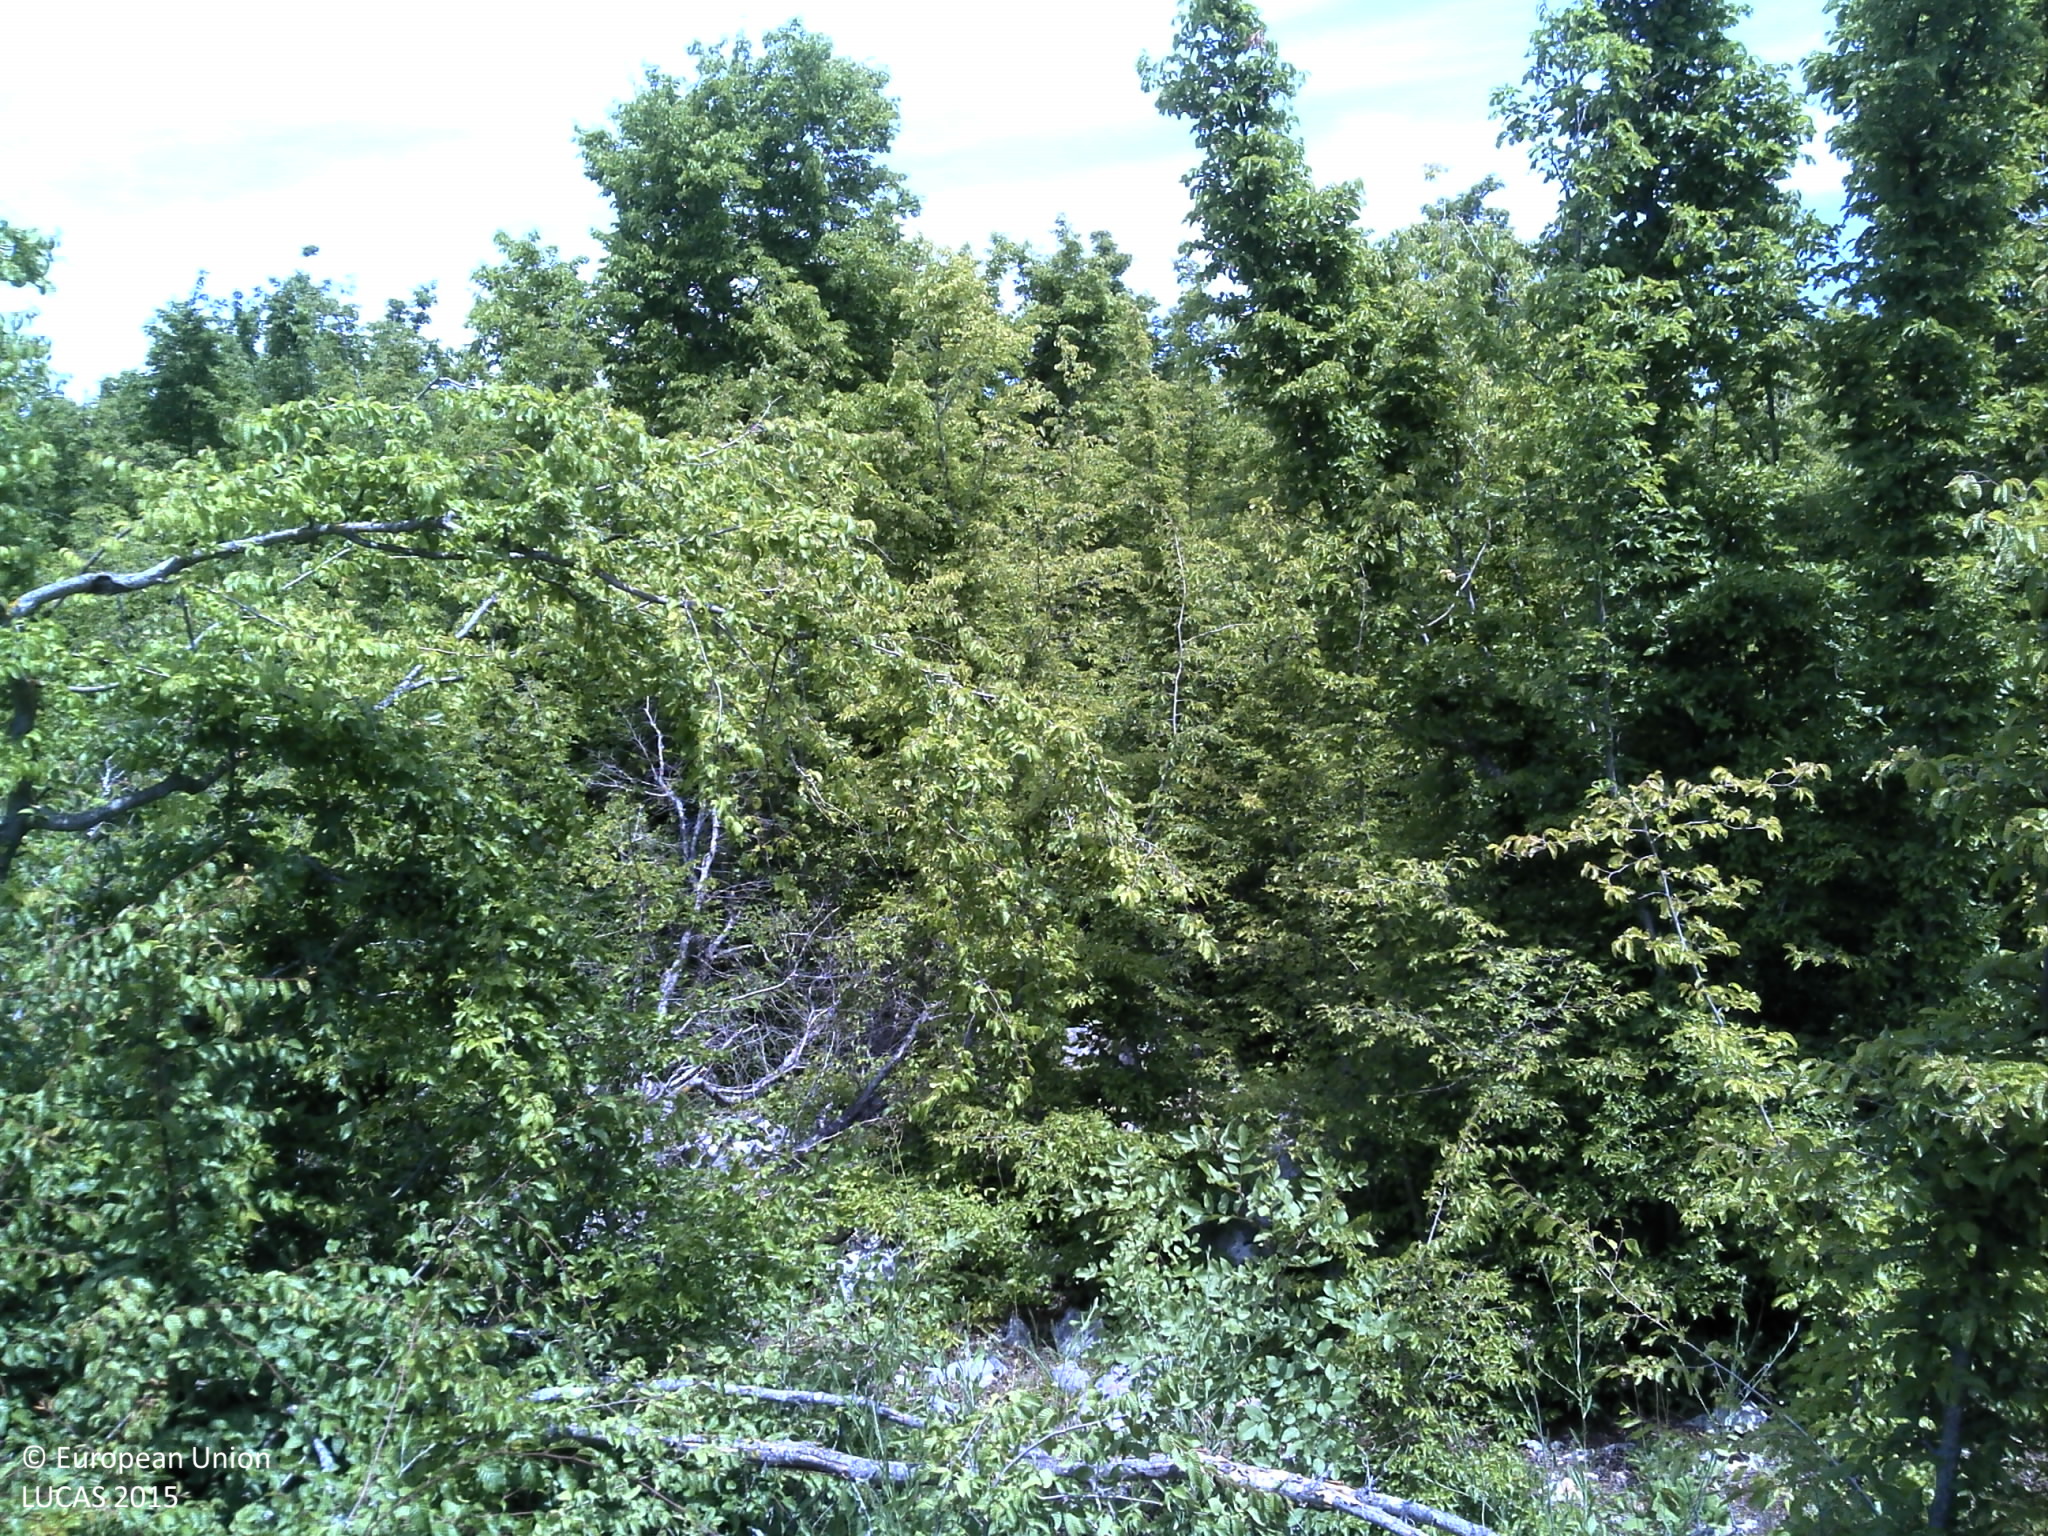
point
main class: Woodland
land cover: Broadleaved woodland
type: thermophilous deciduous forest
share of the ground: 25 - 50 %
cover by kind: shrubs 40 %, broadleaved forest trees 35 %, unconsolidated bare surface 15 %, coniferous forest trees 10 %
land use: Semi-natural and natural areas not in use
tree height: > 5 m
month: June
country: HR
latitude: 44.0671
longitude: 16.0226
